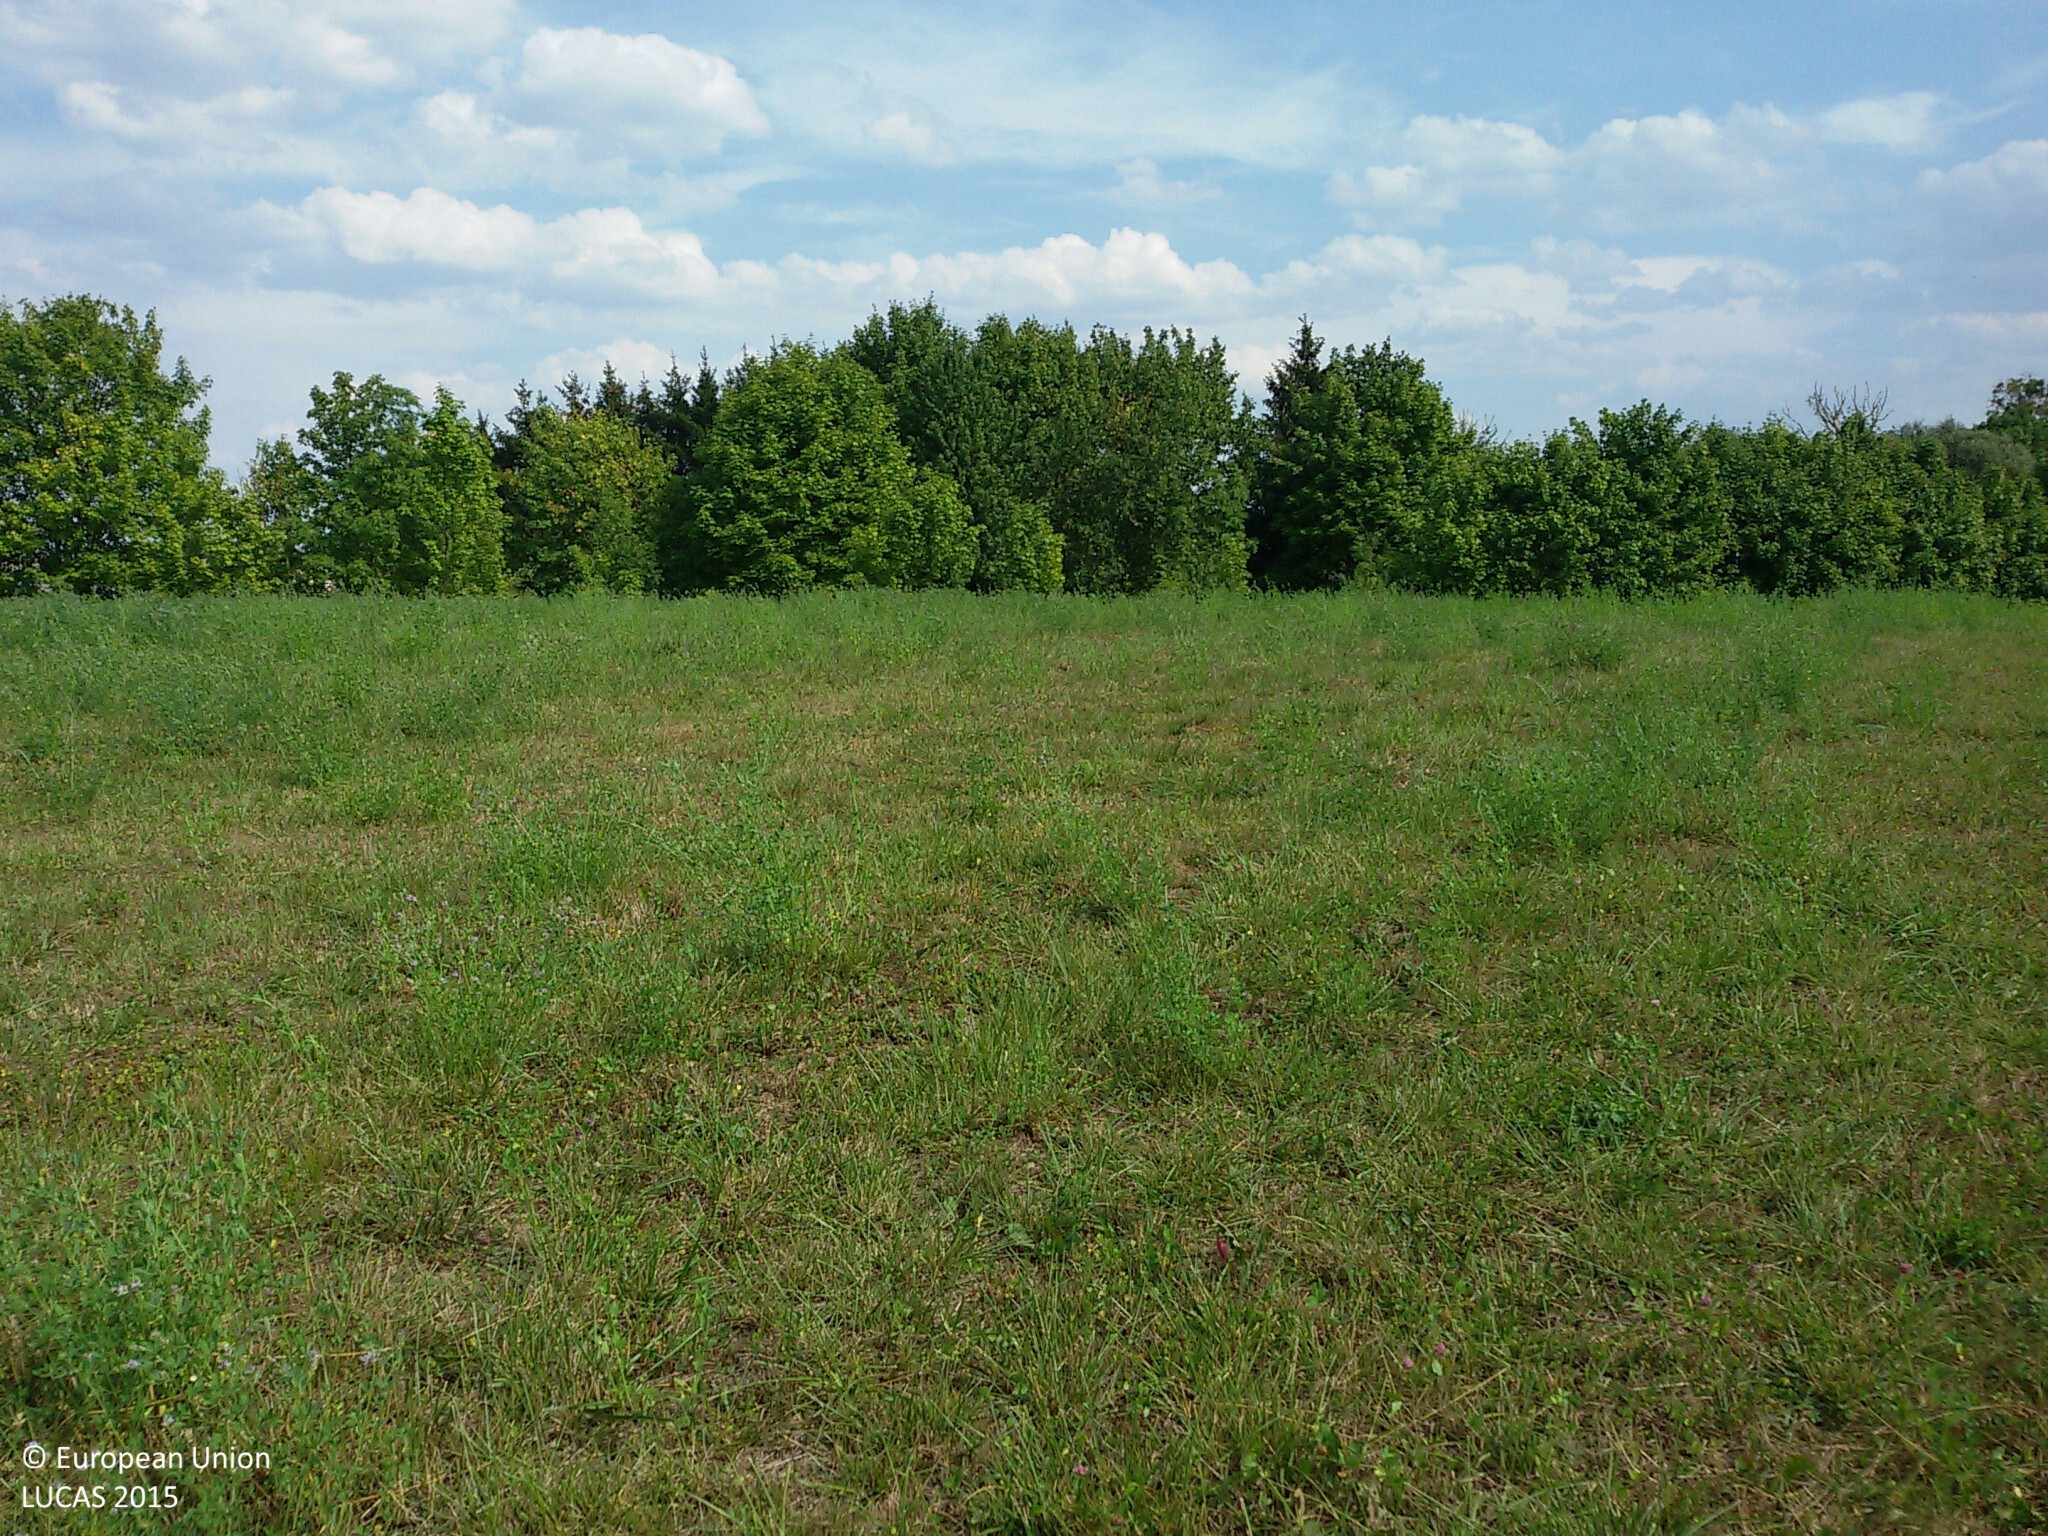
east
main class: Grassland
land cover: Grassland without tree/shrub cover
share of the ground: > 75 %
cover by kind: herbaceous plants 100 %
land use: Agriculture (excluding fallow land and kitchen gardens)
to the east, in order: Grassland without tree/shrub cover; Electric lines; Lines of trees; Paved roads, cycling and walking lanes; Grass margins; Fences; Lines of trees; Grassland without tree/shrub cover; Lines of trees; Artificial constructions in urban areas
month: August
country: PL
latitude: 53.6067
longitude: 20.1746
